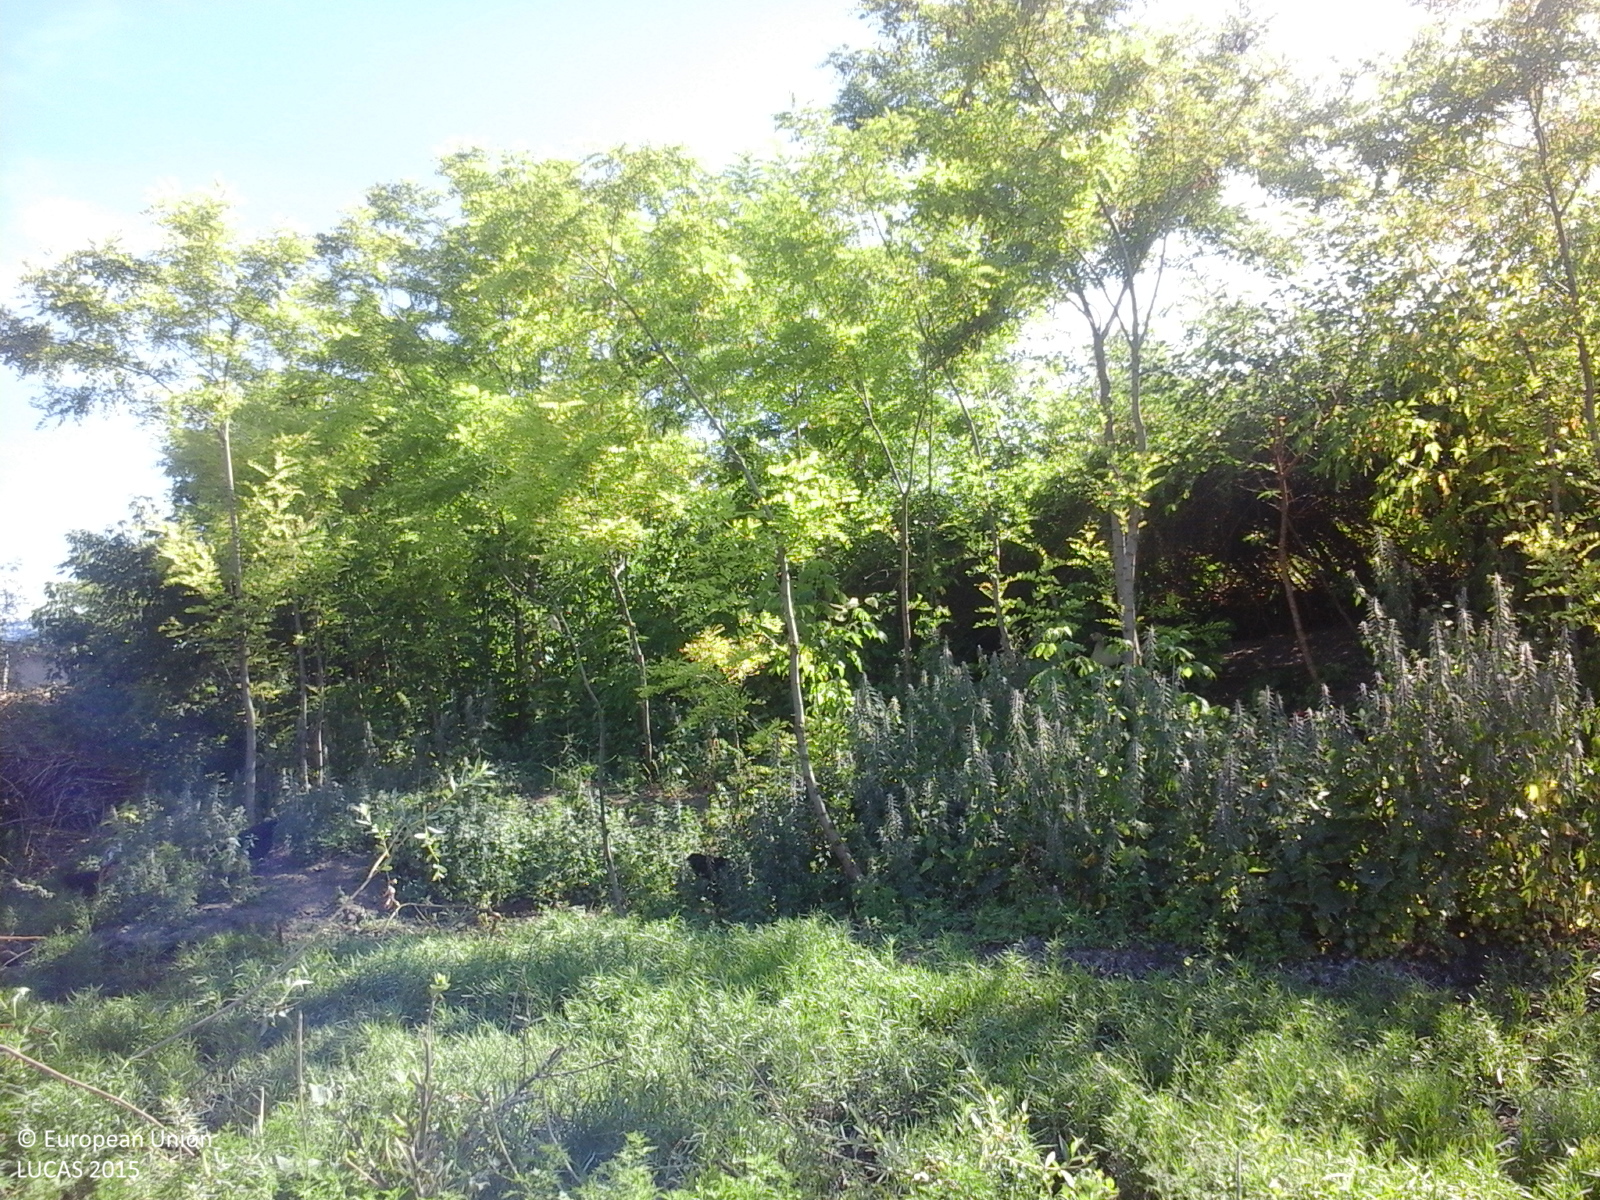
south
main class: Grassland
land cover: Spontaneously vegetated surfaces
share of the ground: > 75 %
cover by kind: herbaceous plants 100 %
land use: Agriculture (excluding fallow land and kitchen gardens)
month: June
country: RO
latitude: 47.2841
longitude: 27.0664
